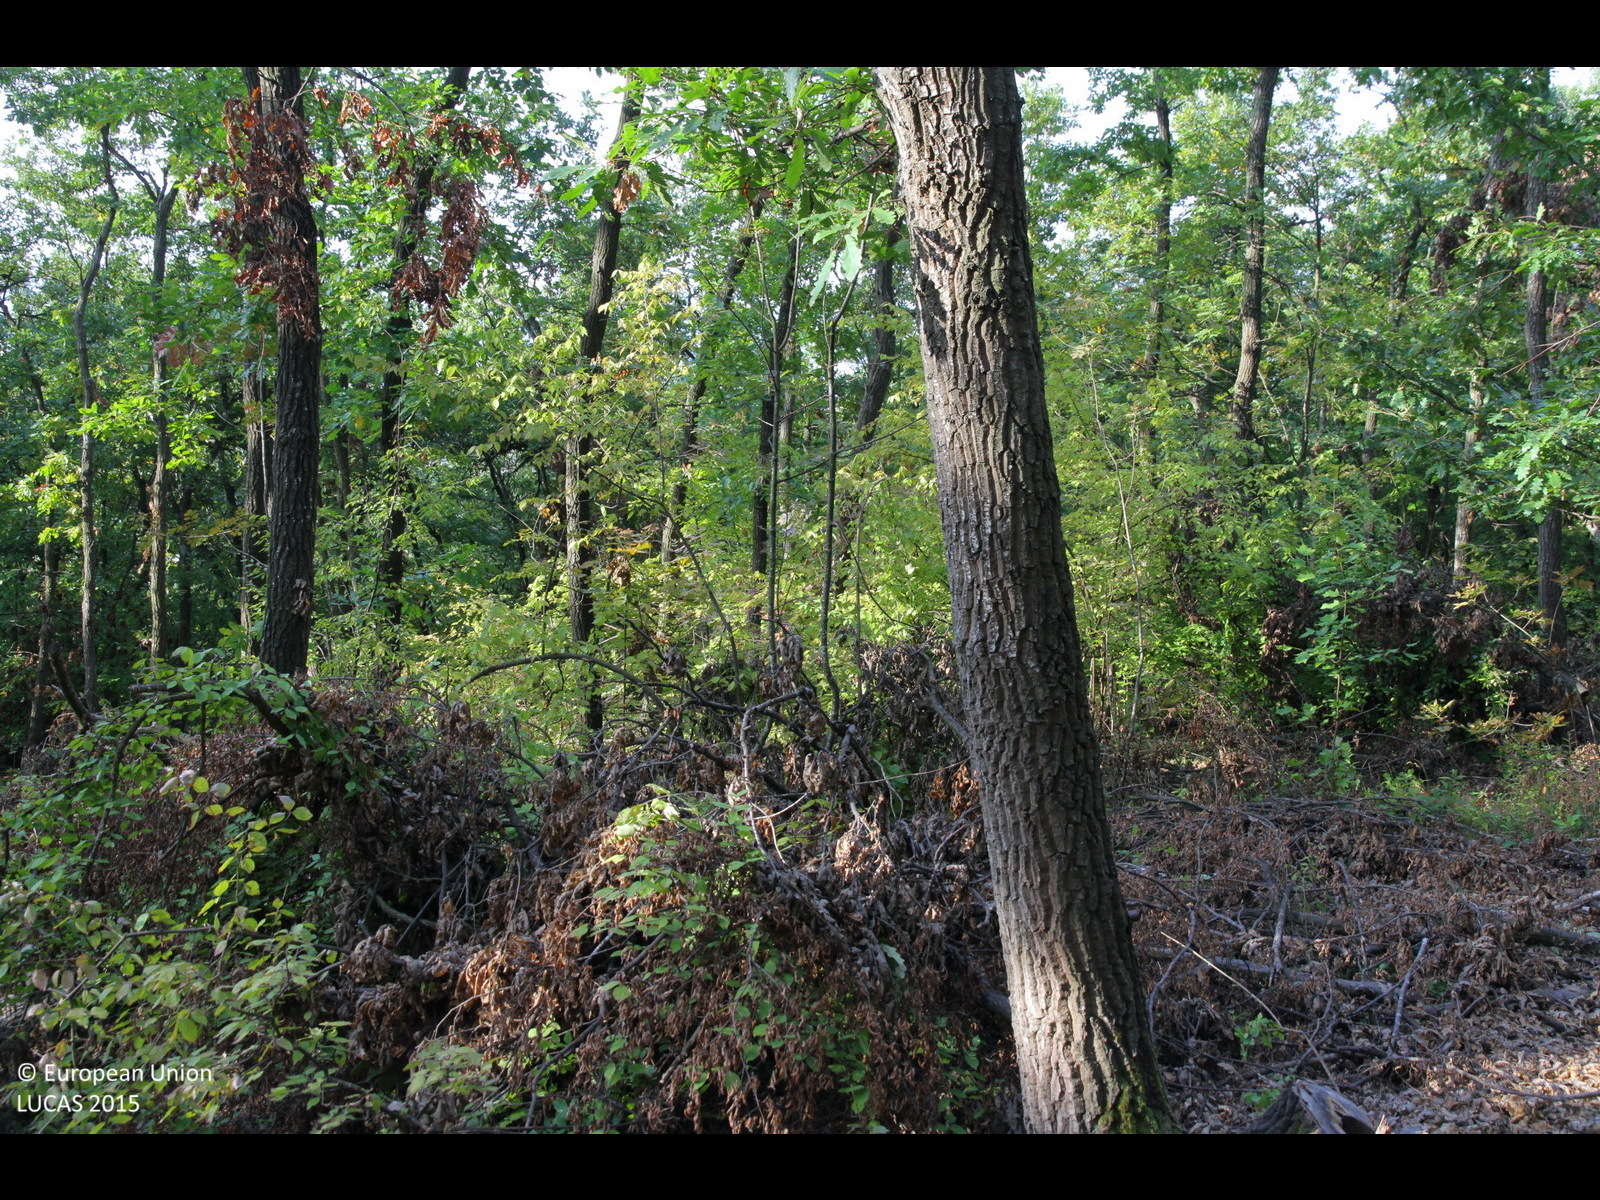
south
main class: Woodland
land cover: Broadleaved woodland
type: acidophilous oak and oak-birch forest
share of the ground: 50 - 75 %
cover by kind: broadleaved forest trees 70 %, unconsolidated bare surface 15 %, herbaceous plants 10 %, shrubs 5 %
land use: Forestry
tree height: > 5 m
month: October
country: BG
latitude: 43.3730
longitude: 27.2401
